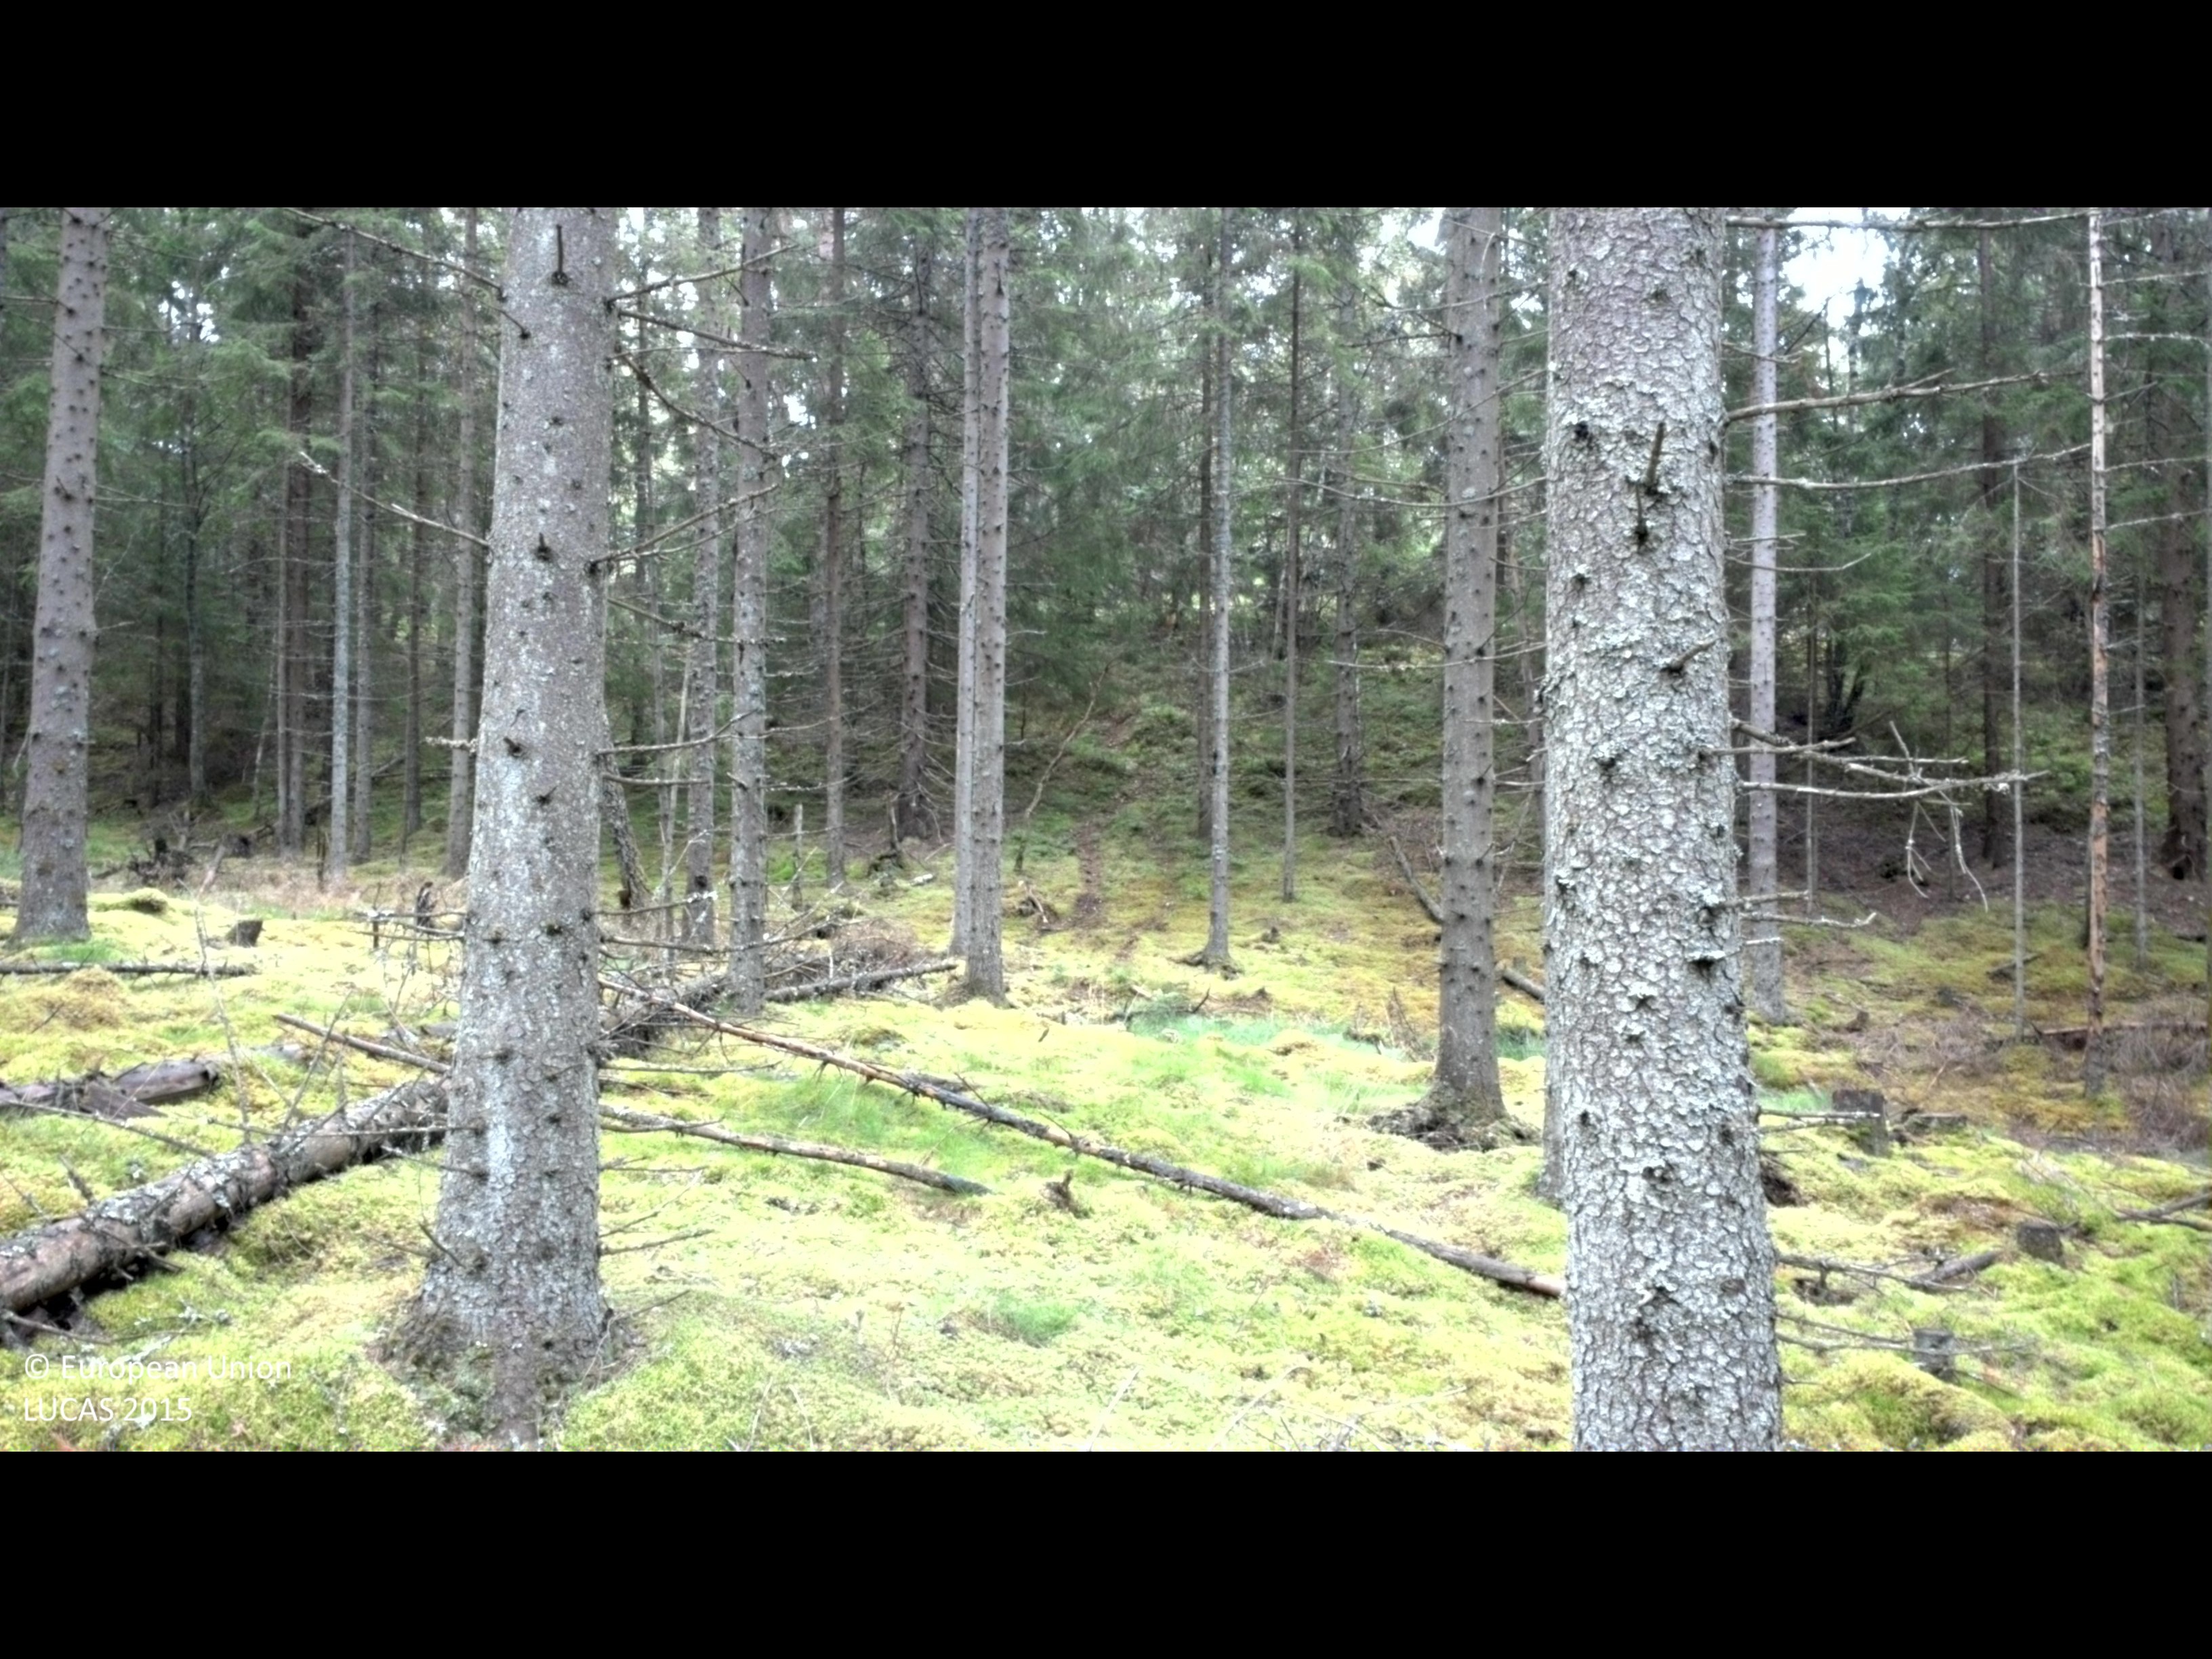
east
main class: Woodland
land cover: Spruce dominated coniferous woodland
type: boreal forest
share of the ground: 50 - 75 %
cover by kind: coniferous forest trees 75 %, lichens and mosses 25 %
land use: Forestry
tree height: > 5 m
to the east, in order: Spruce dominated coniferous woodland; Tracks; Spruce dominated coniferous woodland; Shrubland with sparse tree cover; Spruce dominated mixed woodland; Grassland with sparse tree/shrub cover; Tracks; Grassland with sparse tree/shrub cover; Spruce dominated coniferous woodland; Spruce dominated mixed woodland; Spruce dominated coniferous woodland; Paved roads, cycling and walking lanes; Spruce dominated coniferous woodland
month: August
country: SE
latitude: 57.3007
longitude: 13.8297
